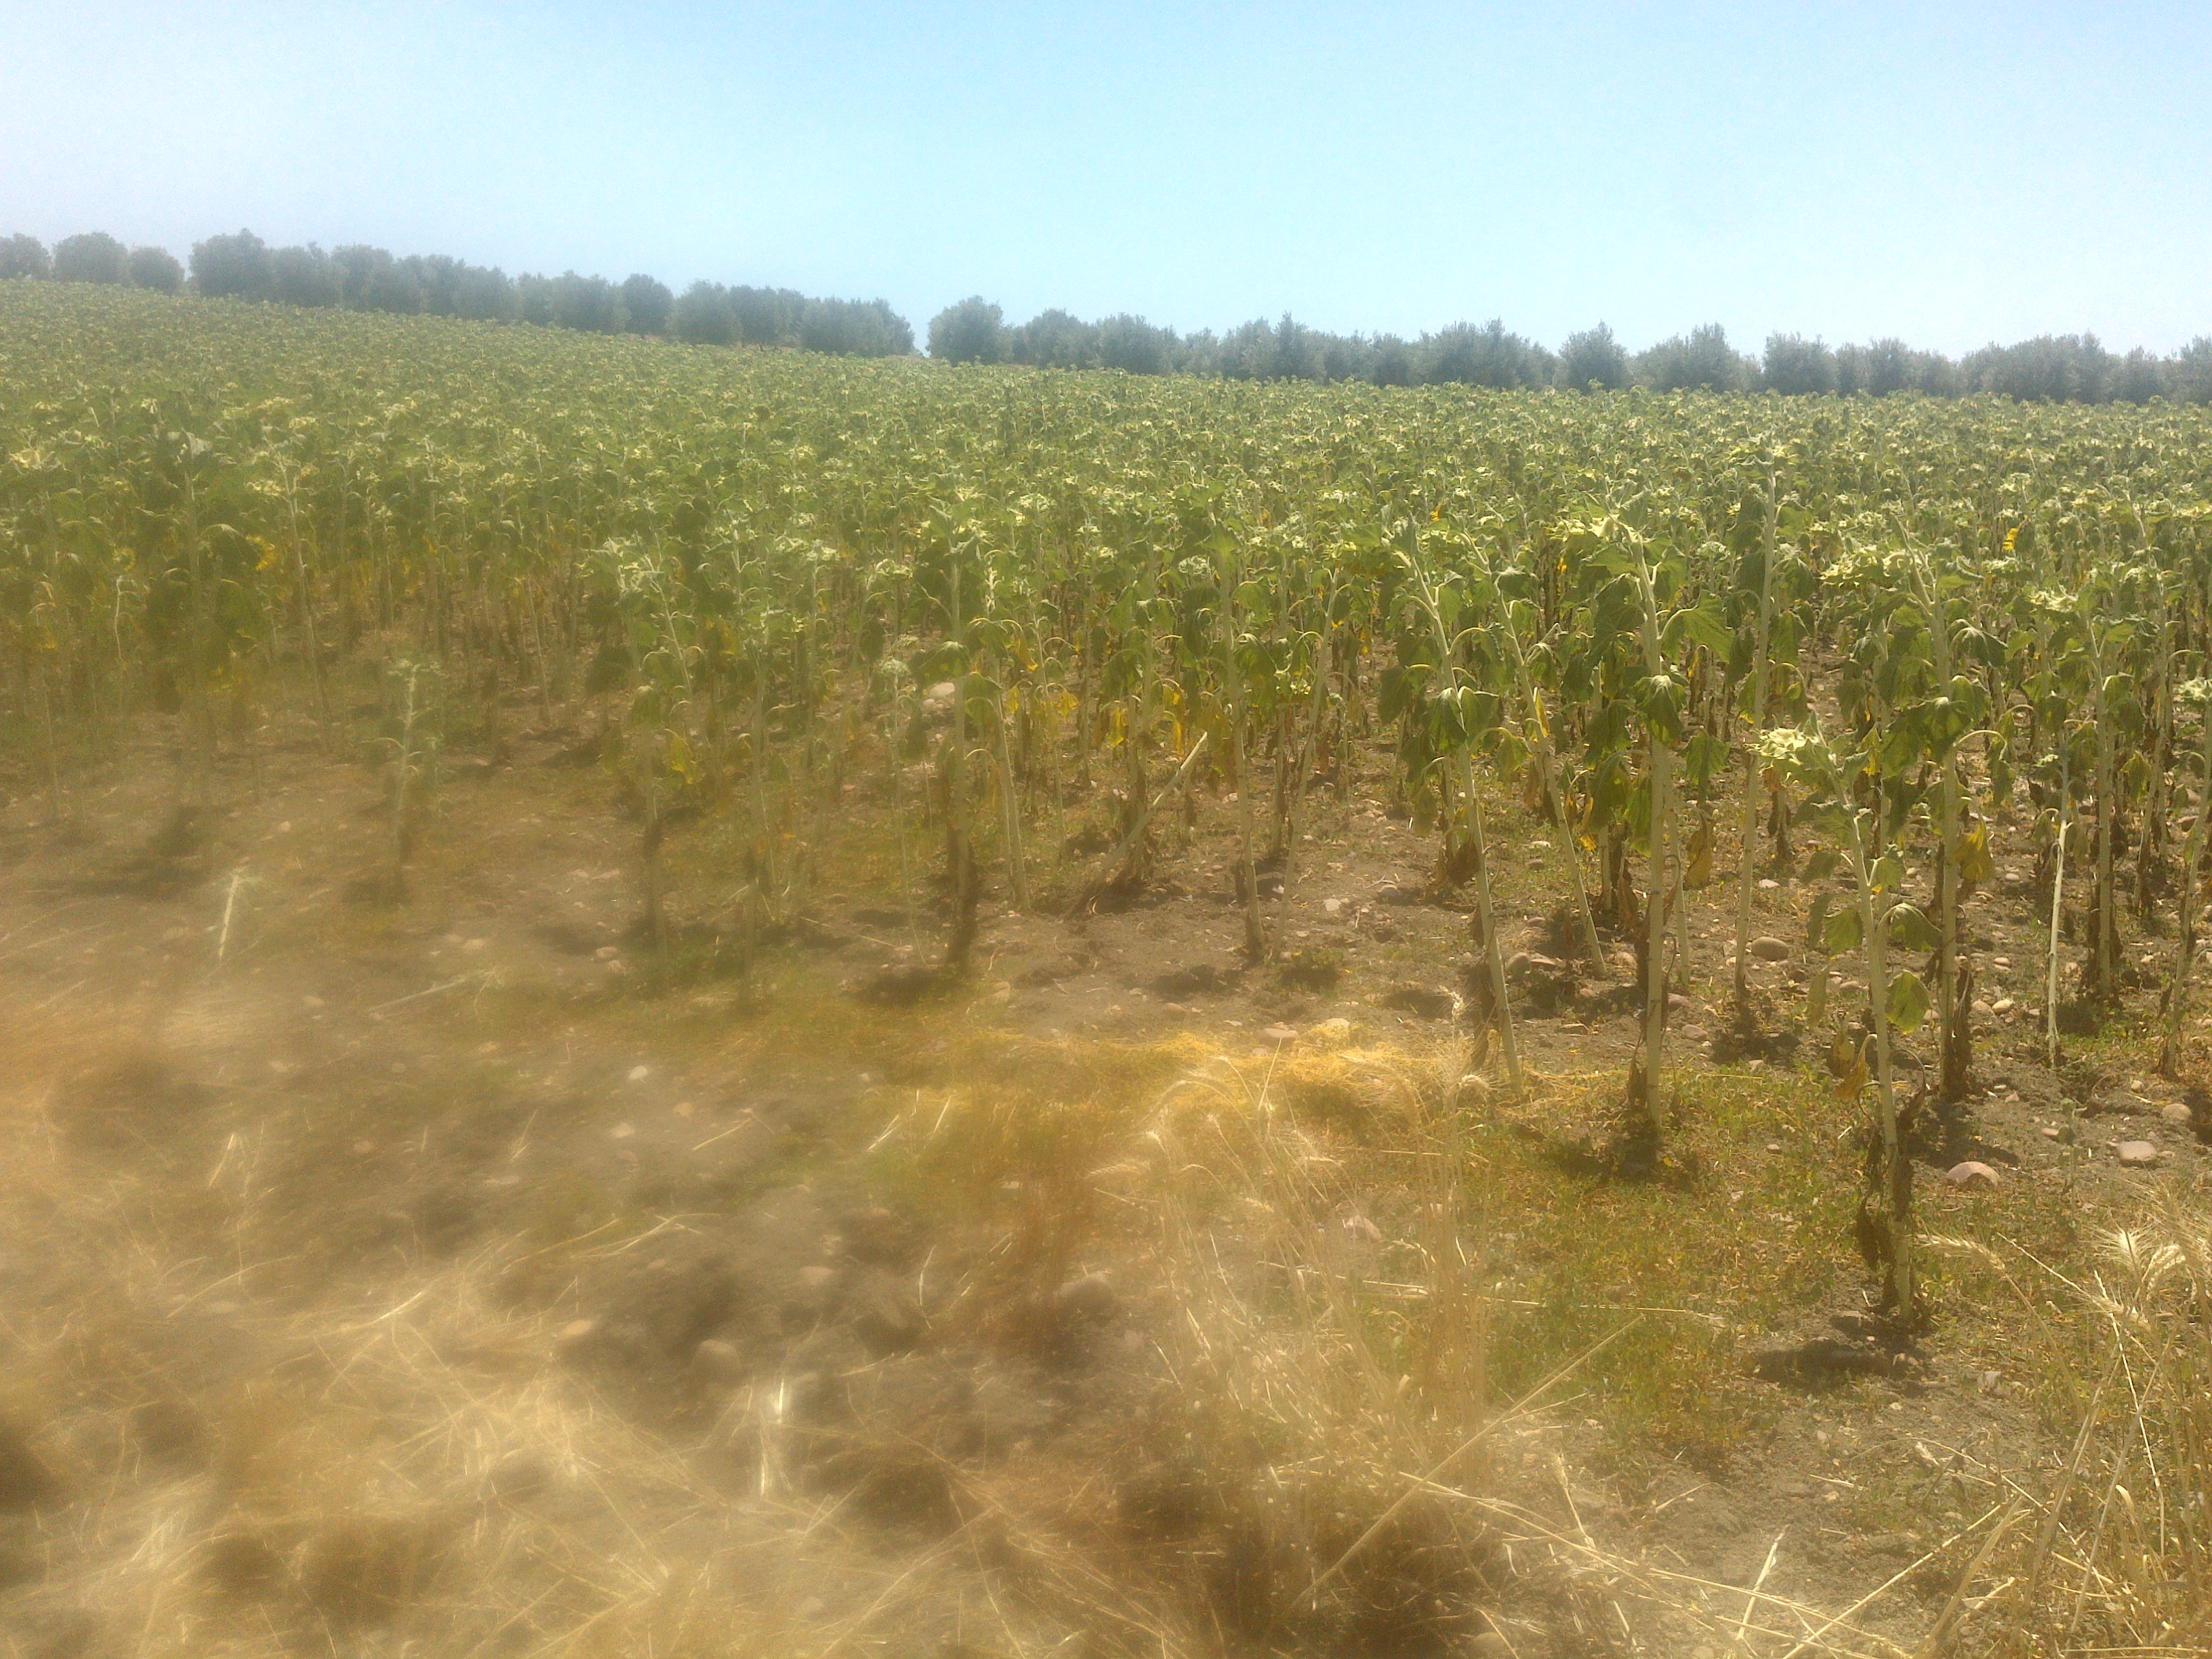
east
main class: Cropland
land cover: Durum wheat
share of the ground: < 10 %
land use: Agriculture (excluding fallow land and kitchen gardens)
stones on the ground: 10 - 25 %
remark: Harvested field
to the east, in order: Durum wheat; Sunflower; Grass margins; Tracks; Olive groves
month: June
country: ES
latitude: 37.6708
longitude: -4.8984
